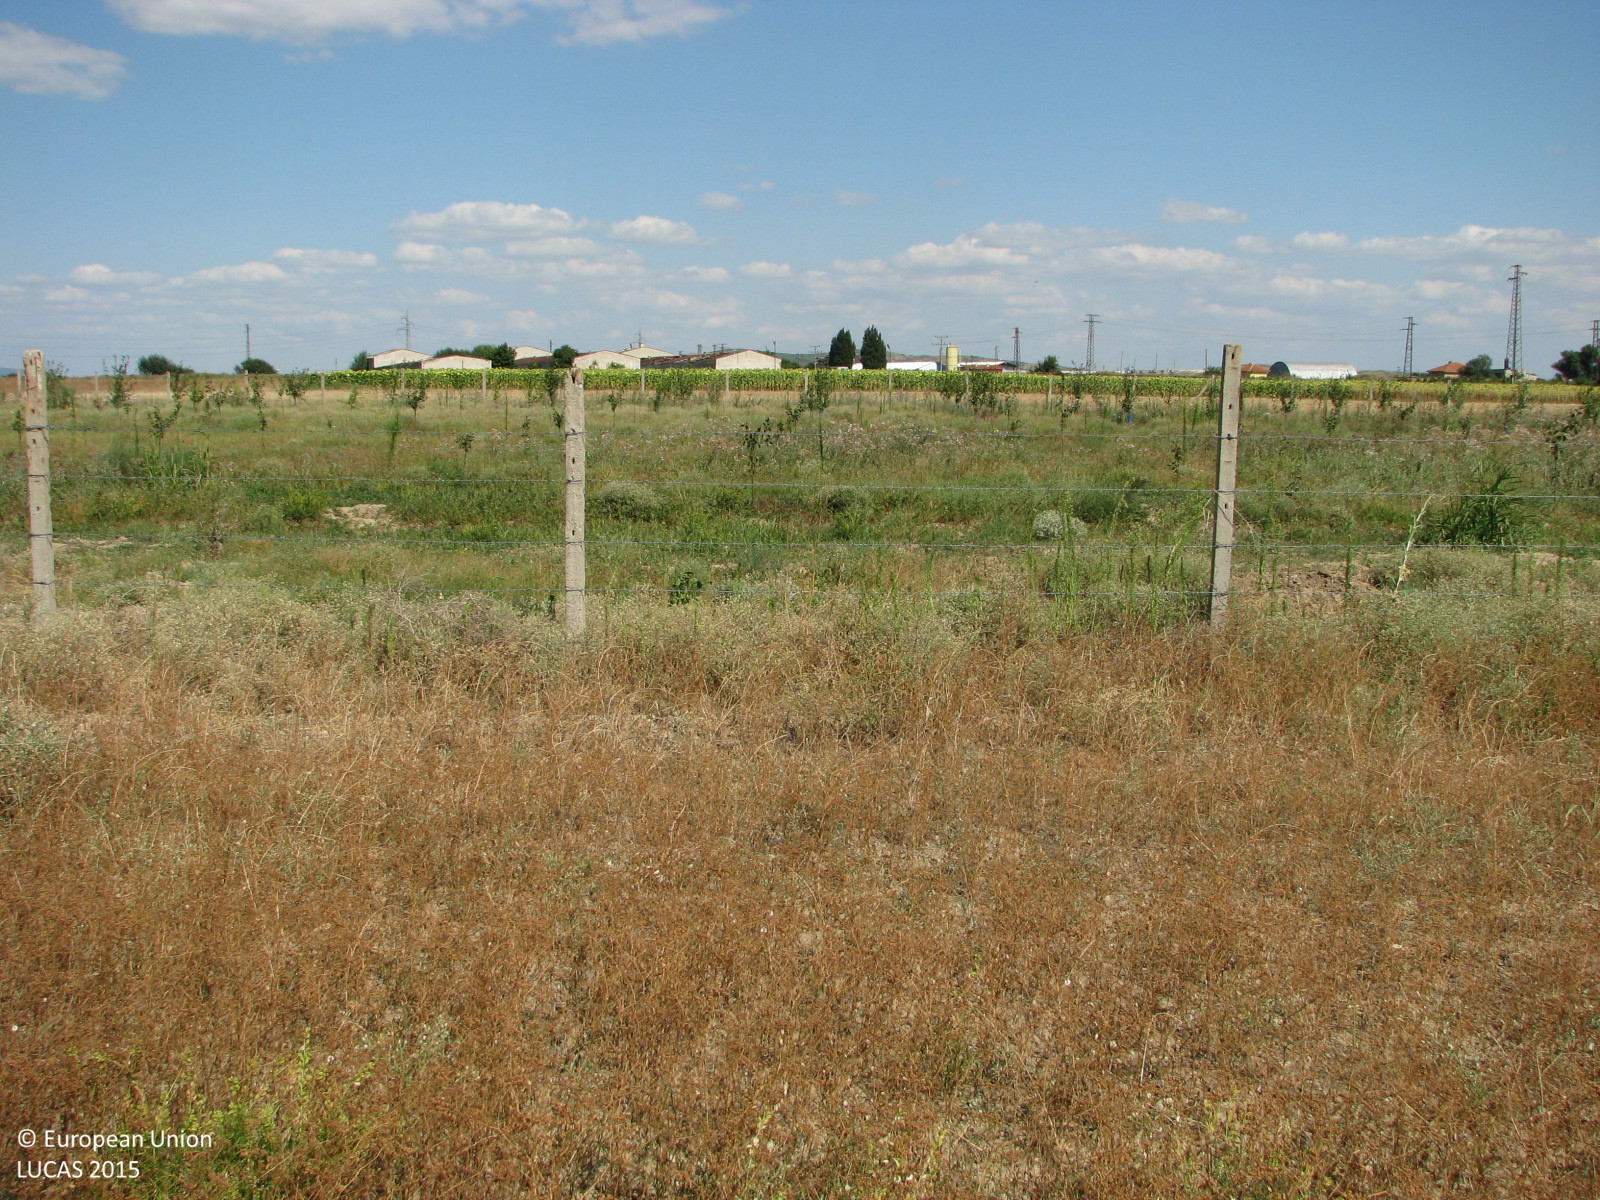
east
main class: Cropland
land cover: Other non-permanent industrial crops
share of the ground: > 75 %
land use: Agriculture (excluding fallow land and kitchen gardens)
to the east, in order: Other non-permanent industrial crops; Grass margins; Fences; Other fruit trees and berries; Fences; Common wheat; Other non-permanent industrial crops; Spontaneously vegetated surfaces
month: July
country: BG
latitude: 42.6255
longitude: 26.3184
